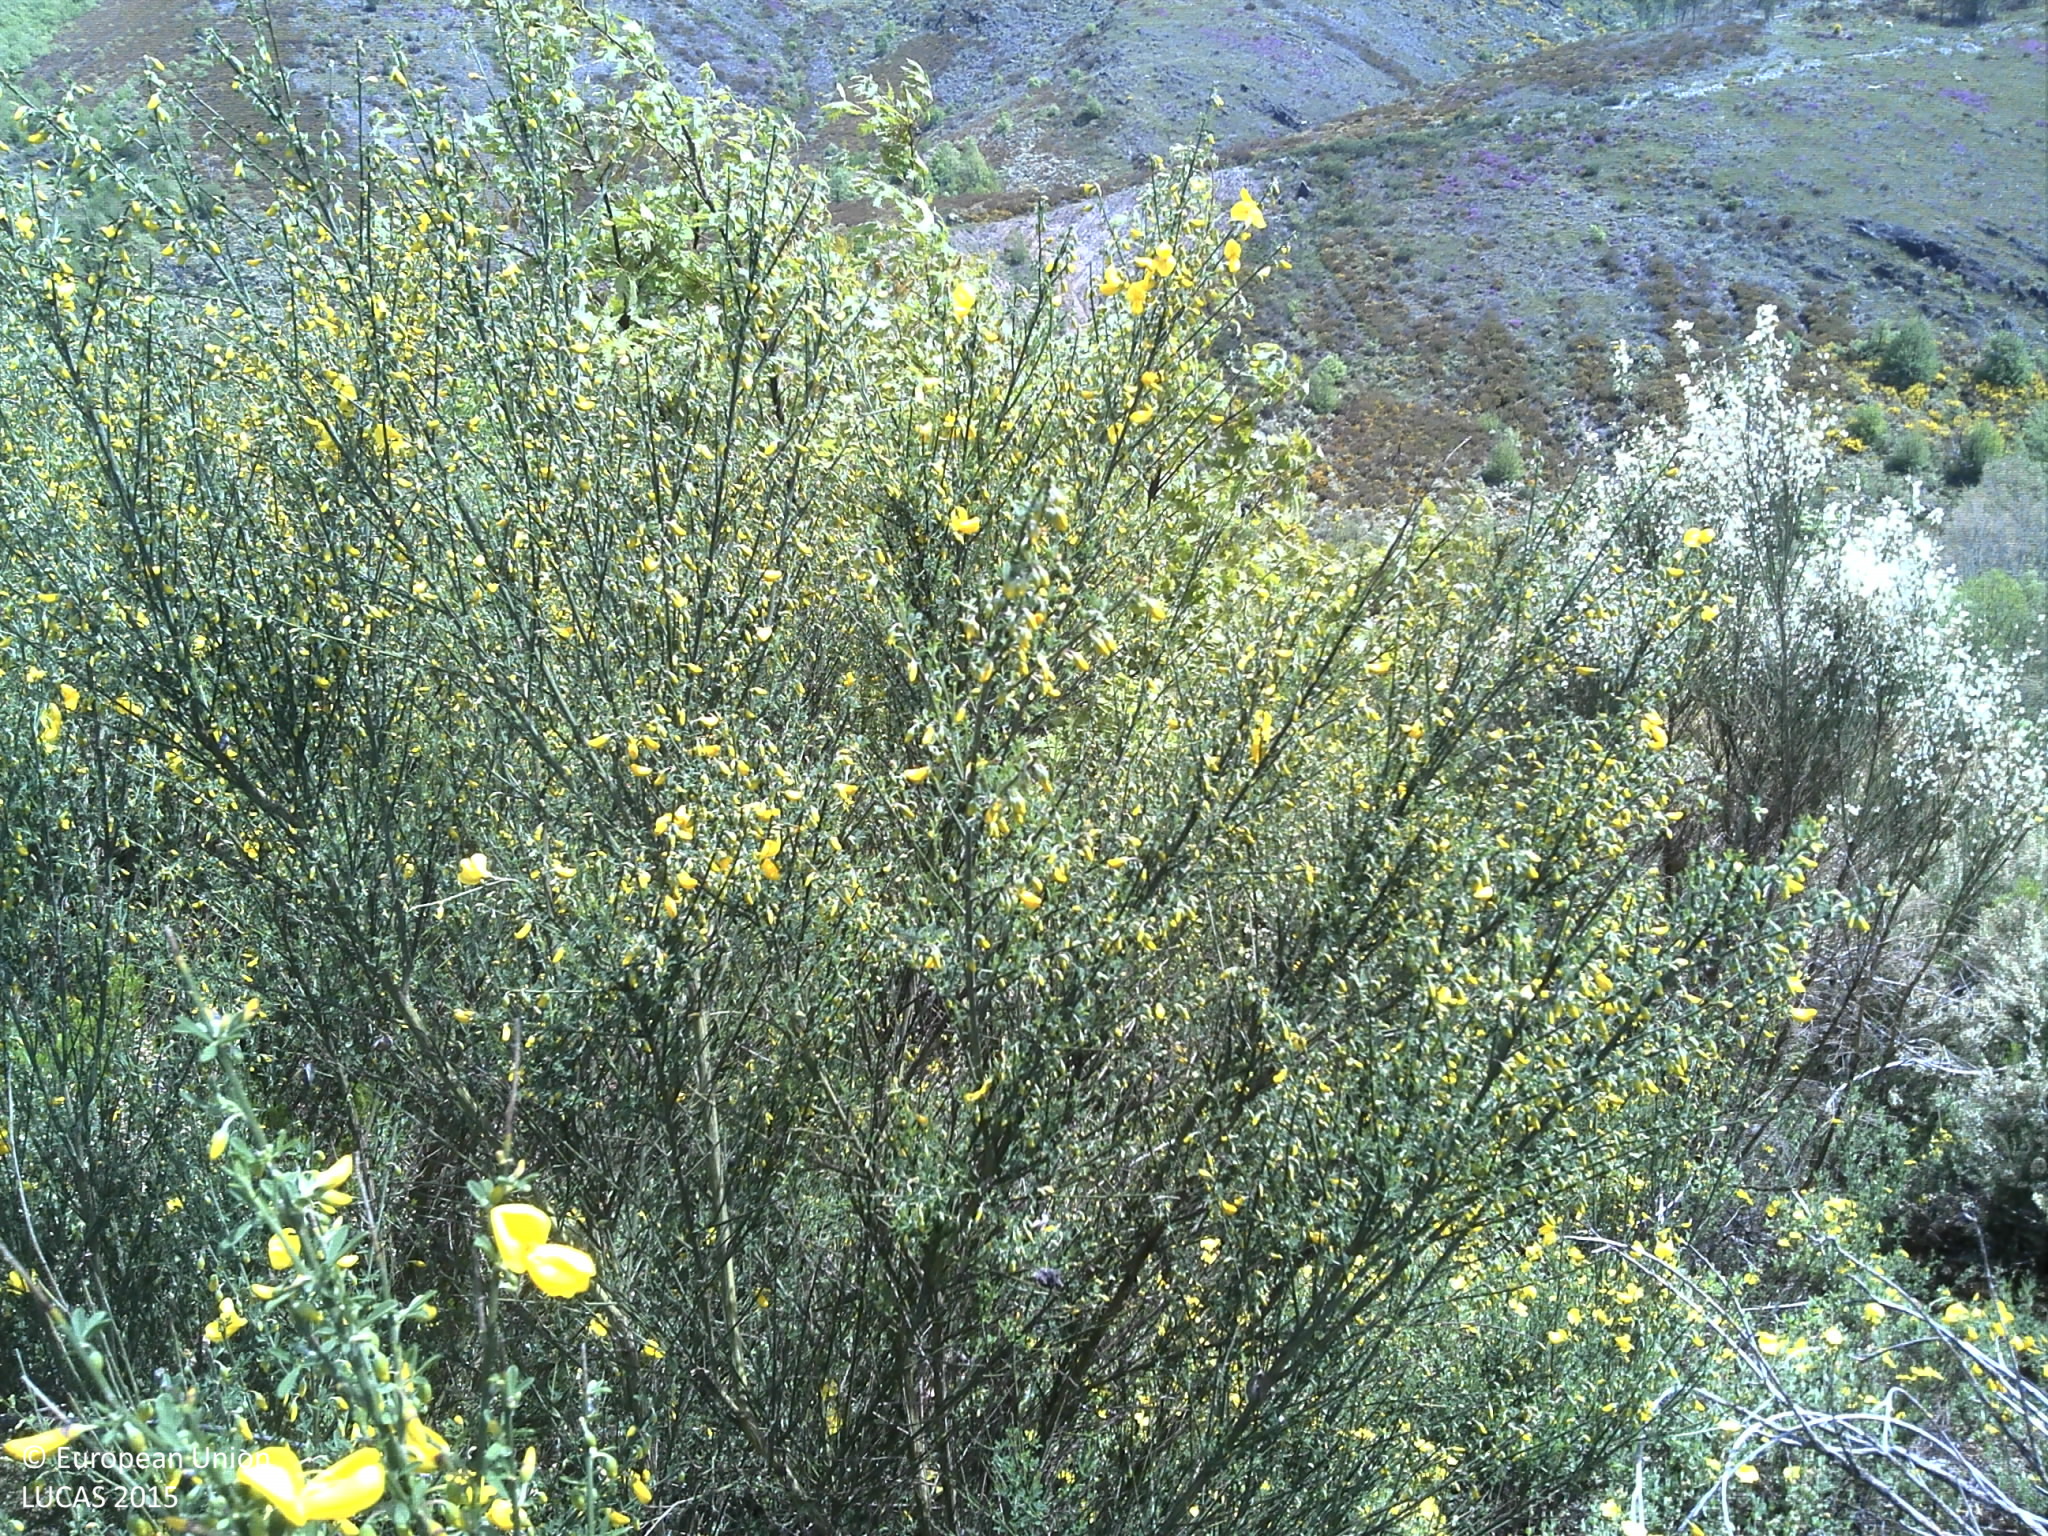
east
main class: Shrubland
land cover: Shrubland with sparse tree cover
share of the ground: > 75 %
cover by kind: shrubs 85 %, herbaceous plants 10 %, broadleaved forest trees 5 %
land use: Forestry
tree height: < 5 m
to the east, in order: Shrubland with sparse tree cover; Tracks; Abandoned hedges; Fences; Ditches and canals; Grassland without tree/shrub cover; Fences; Abandoned hedges; Rivers and streams; Grassland with sparse tree/shrub cover; Shrubland with sparse tree cover
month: May
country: PT
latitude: 41.9338
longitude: -7.0426
